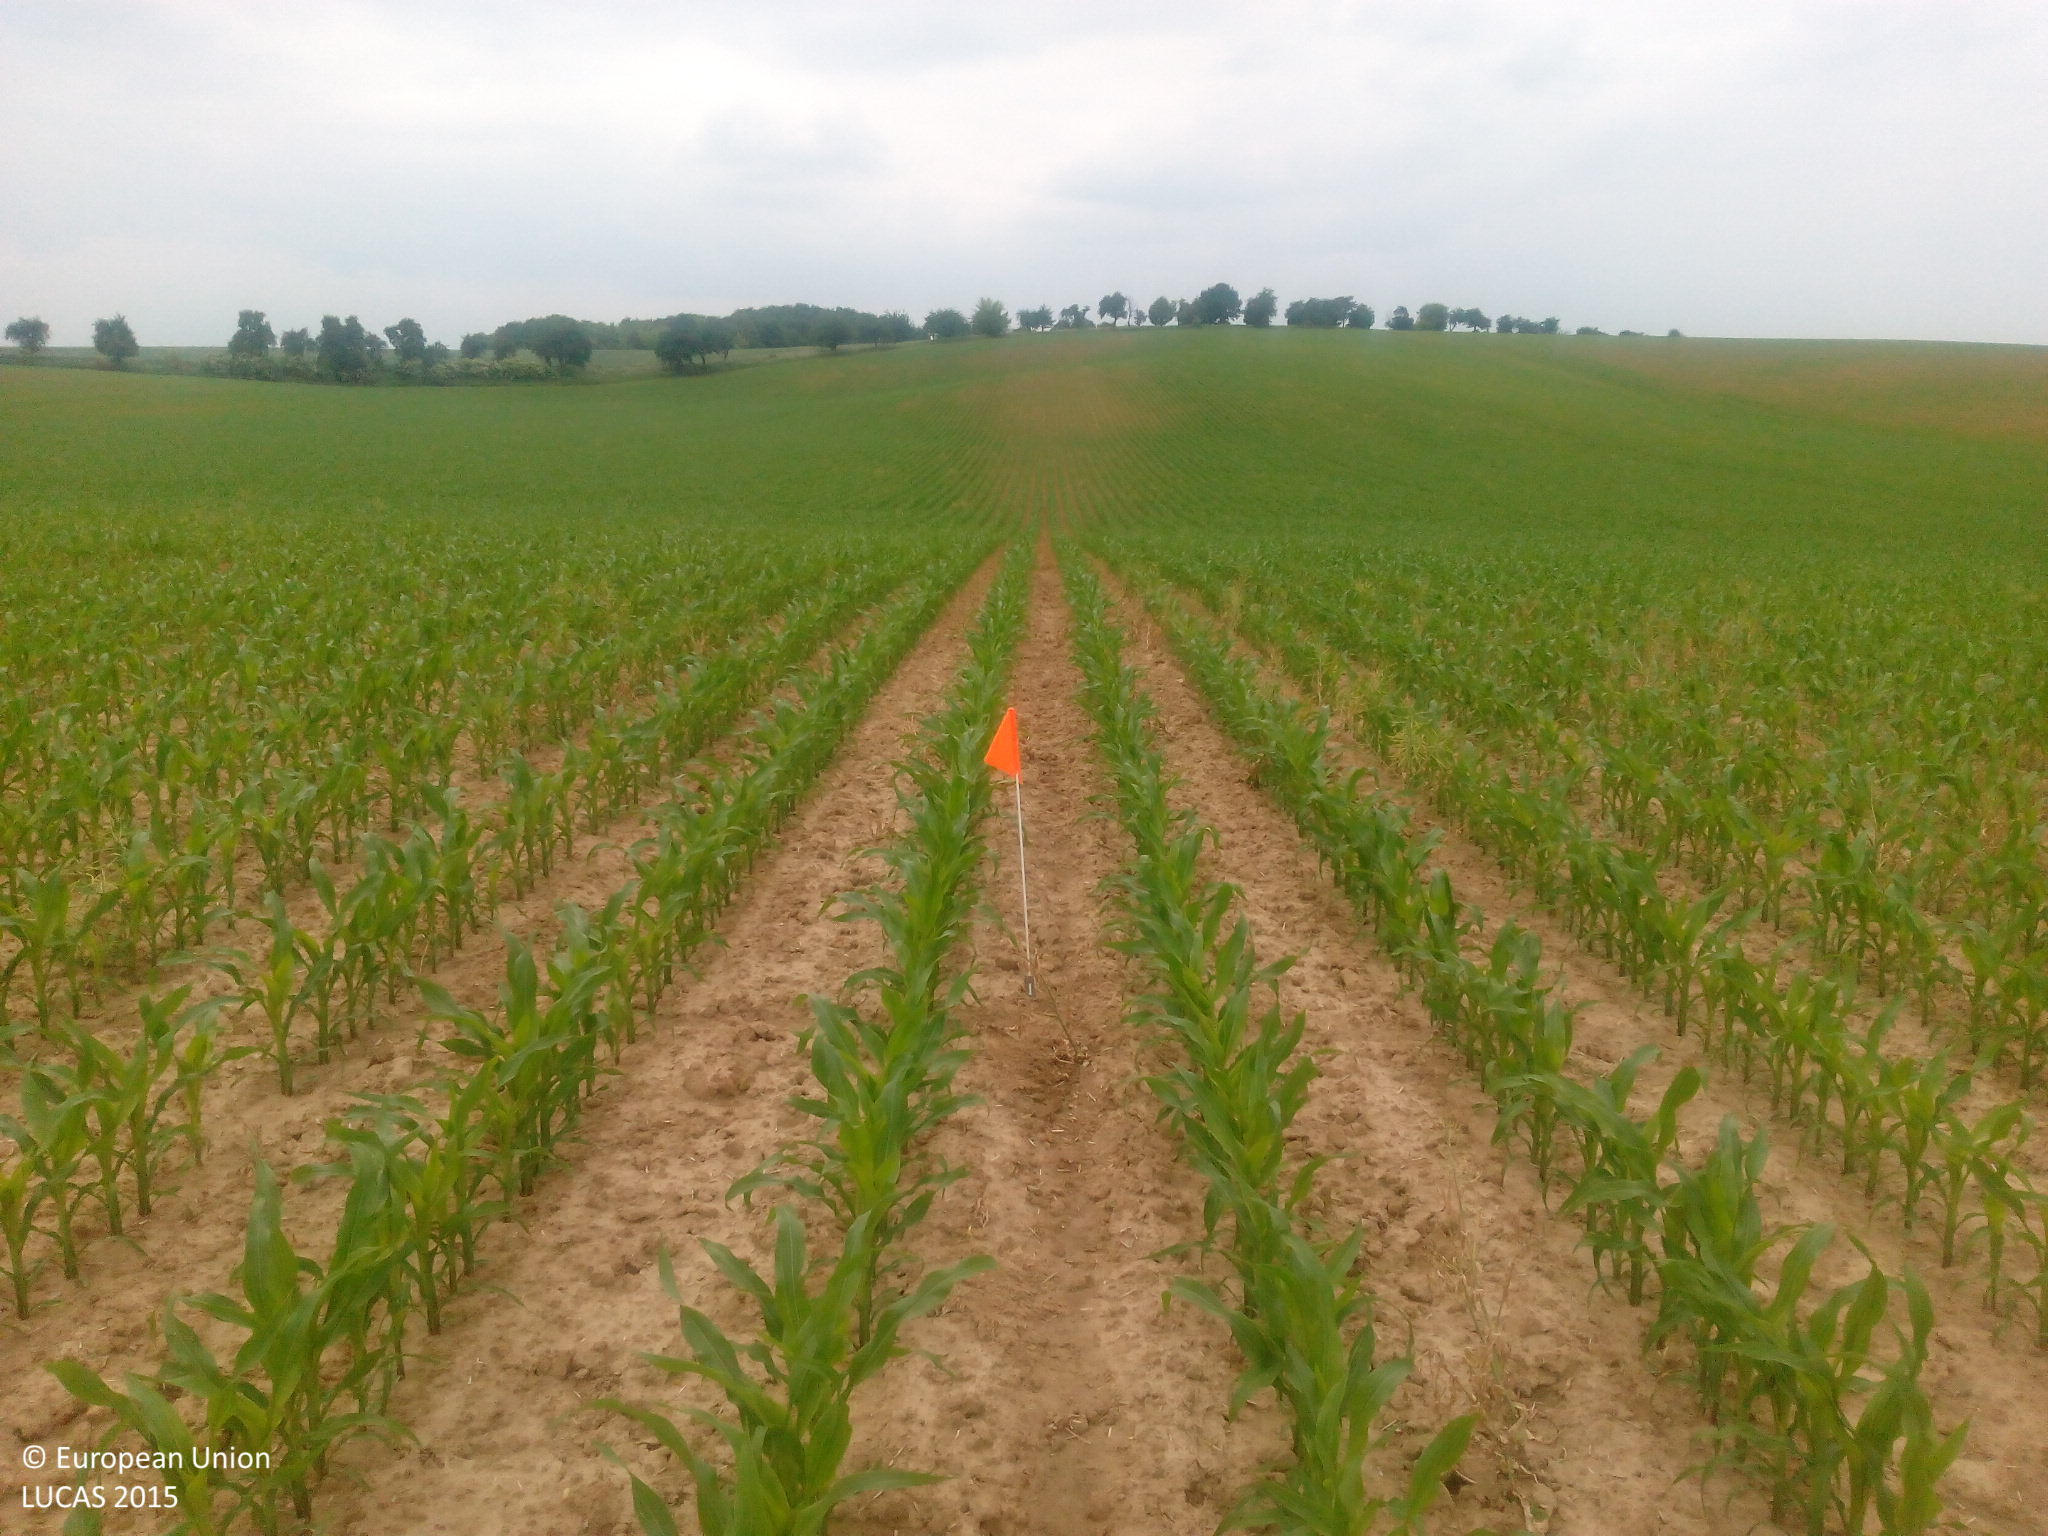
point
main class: Cropland
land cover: Maize
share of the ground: 25 - 50 %
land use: Agriculture (excluding fallow land and kitchen gardens)
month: June
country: DE
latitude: 51.2036
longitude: 13.1059
